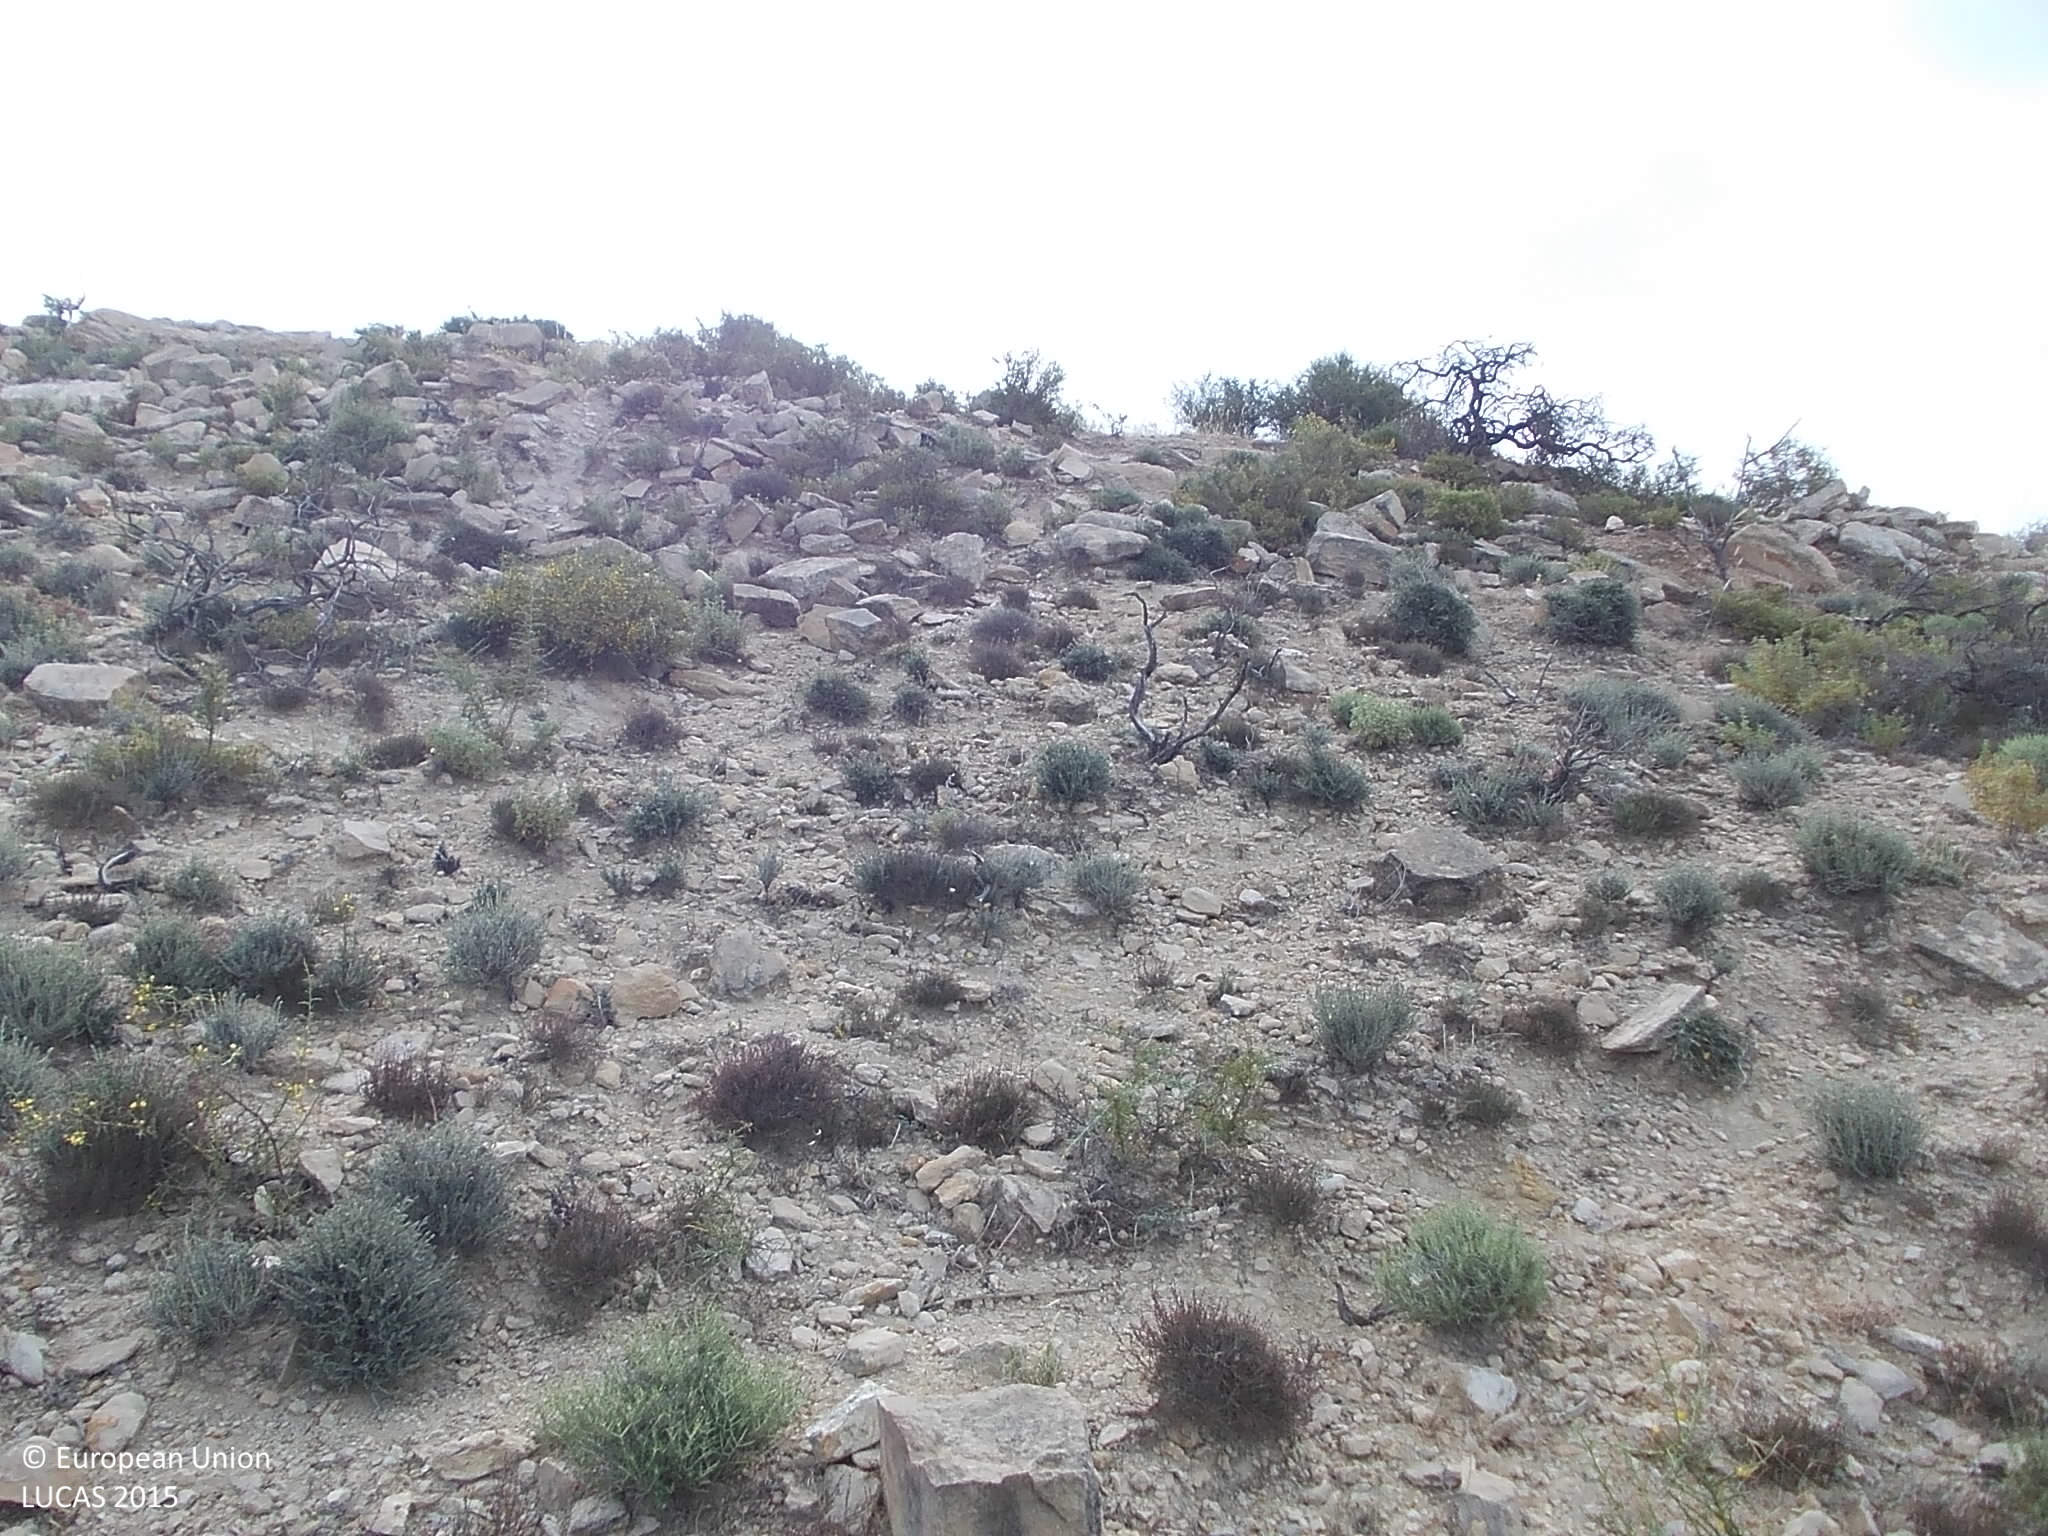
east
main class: Shrubland
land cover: Shrubland without tree cover
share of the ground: 25 - 50 %
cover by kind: shrubs 50 %, consolidated bare surface 20 %, unconsolidated bare surface 20 %, herbaceous plants 10 %
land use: Semi-natural and natural areas not in use
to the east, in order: Shrubland without tree cover; Grassland with sparse tree/shrub cover; Tracks; Shrubland with sparse tree cover; Electric lines; Shrubland with sparse tree cover; Dry stone walls; Shrubland with sparse tree cover; Dry stone walls; Shrubland with sparse tree cover; Dry stone walls; Shrubland with sparse tree cover; Dry stone walls; Shrubland with sparse tree cover; Dry stone walls; Shrubland with sparse tree cover
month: May
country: CY
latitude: 34.7370
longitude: 33.0029
